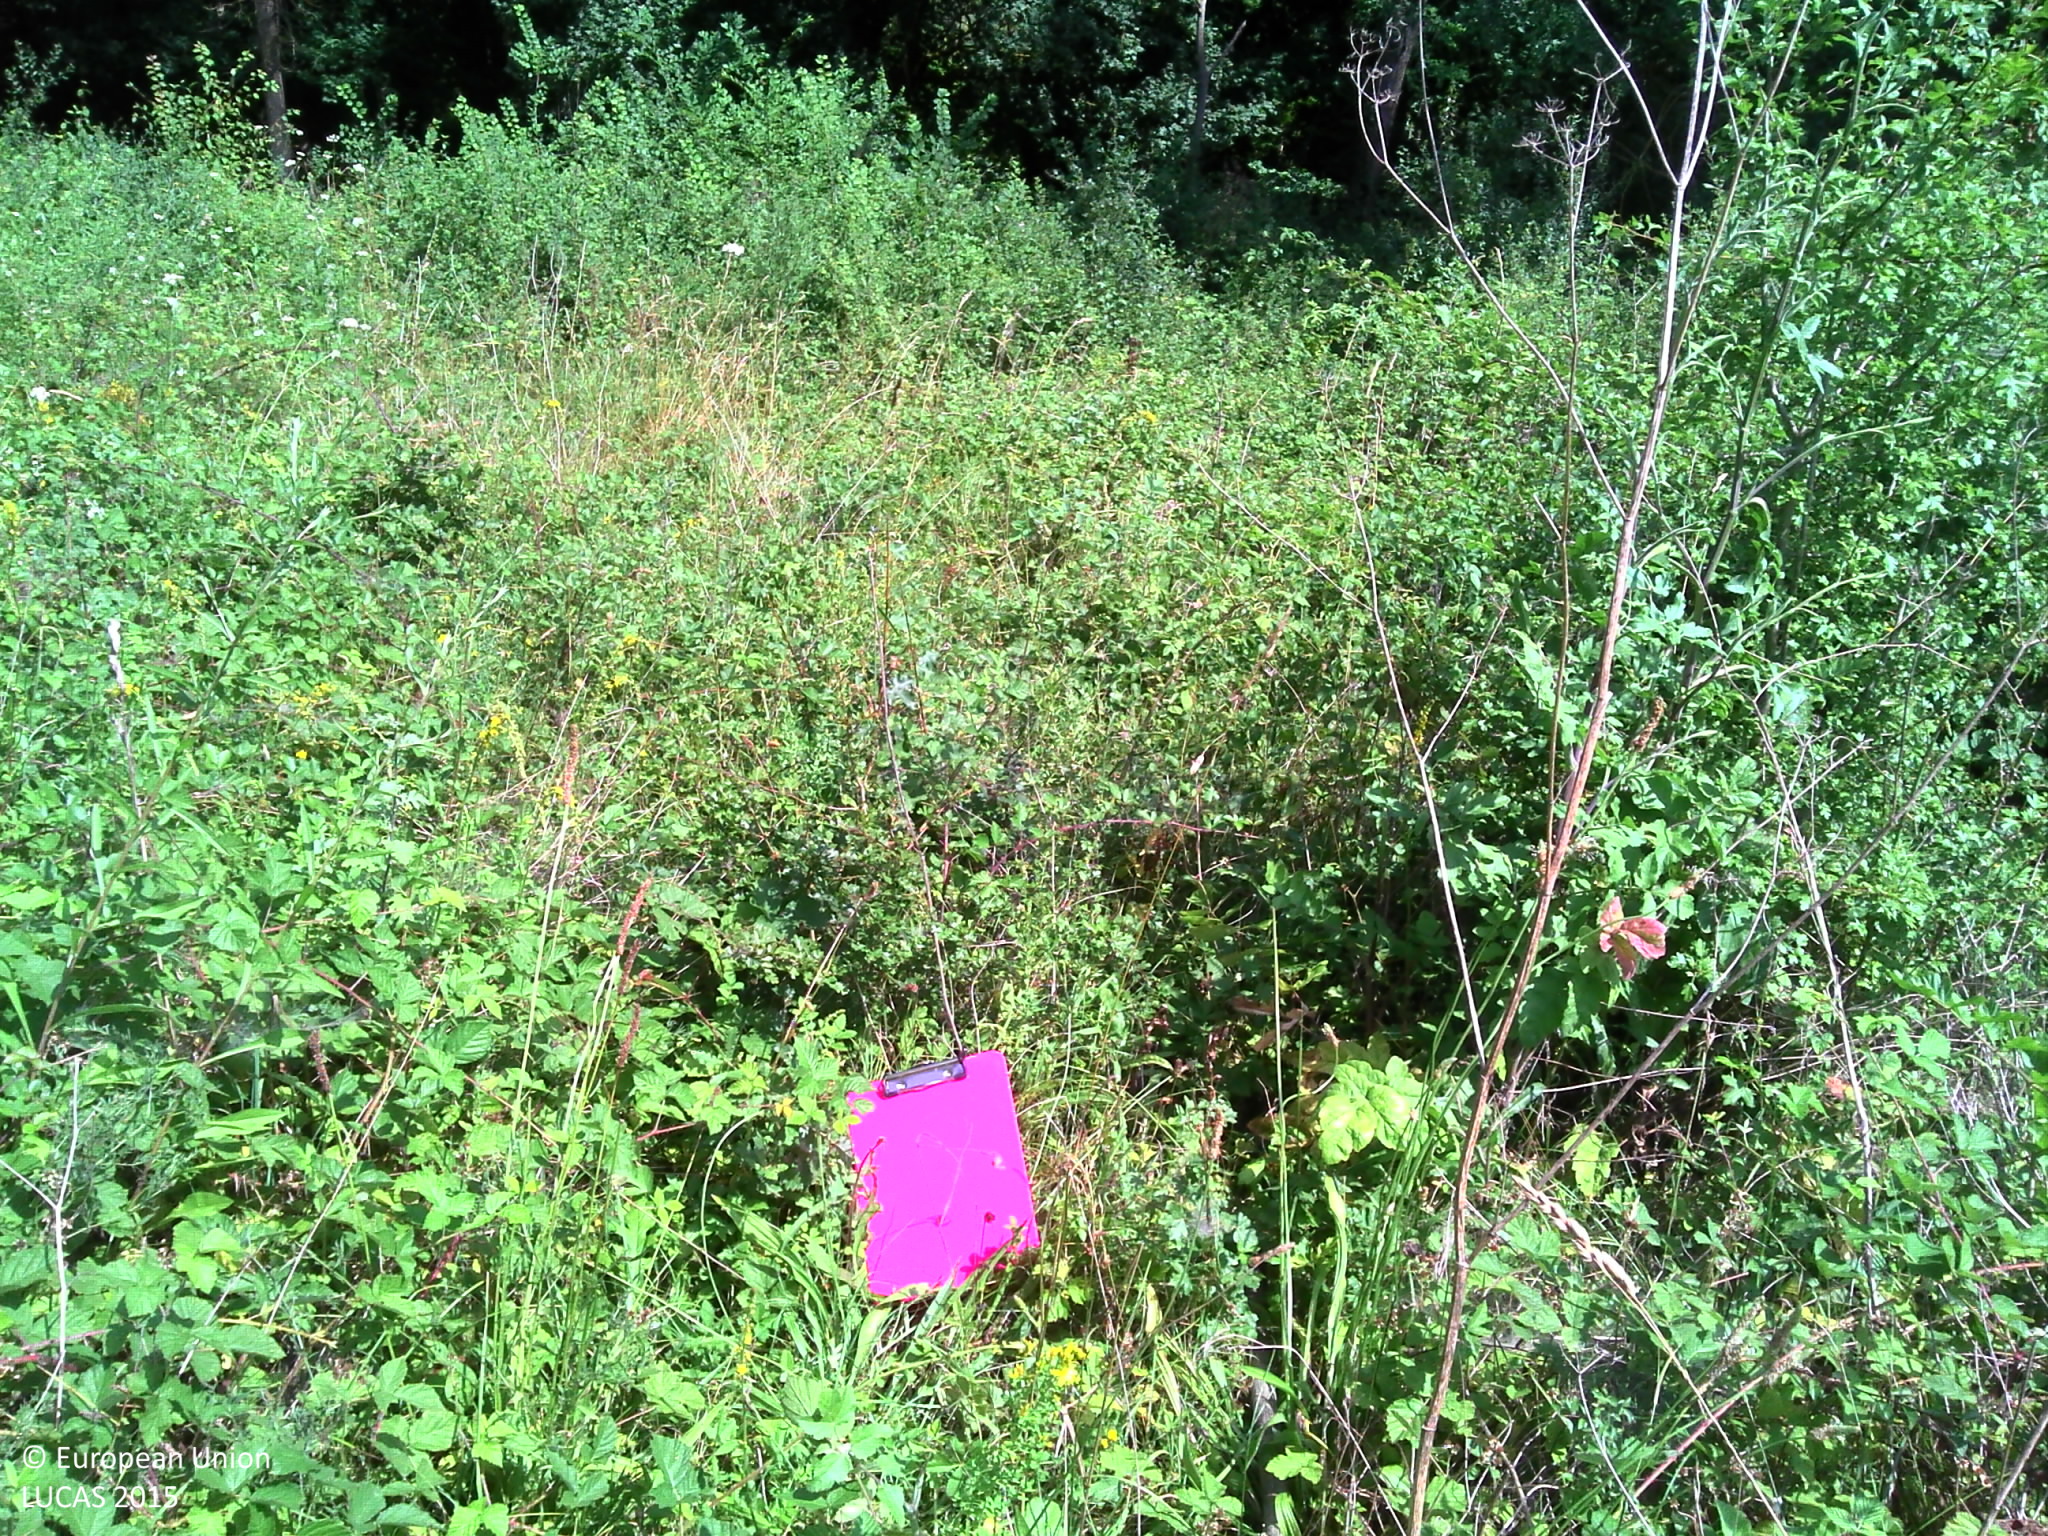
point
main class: Grassland
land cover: Spontaneously vegetated surfaces
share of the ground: > 75 %
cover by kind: herbaceous plants 100 %
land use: Semi-natural and natural areas not in use
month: July
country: FR
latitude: 43.1953
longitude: 1.4030
